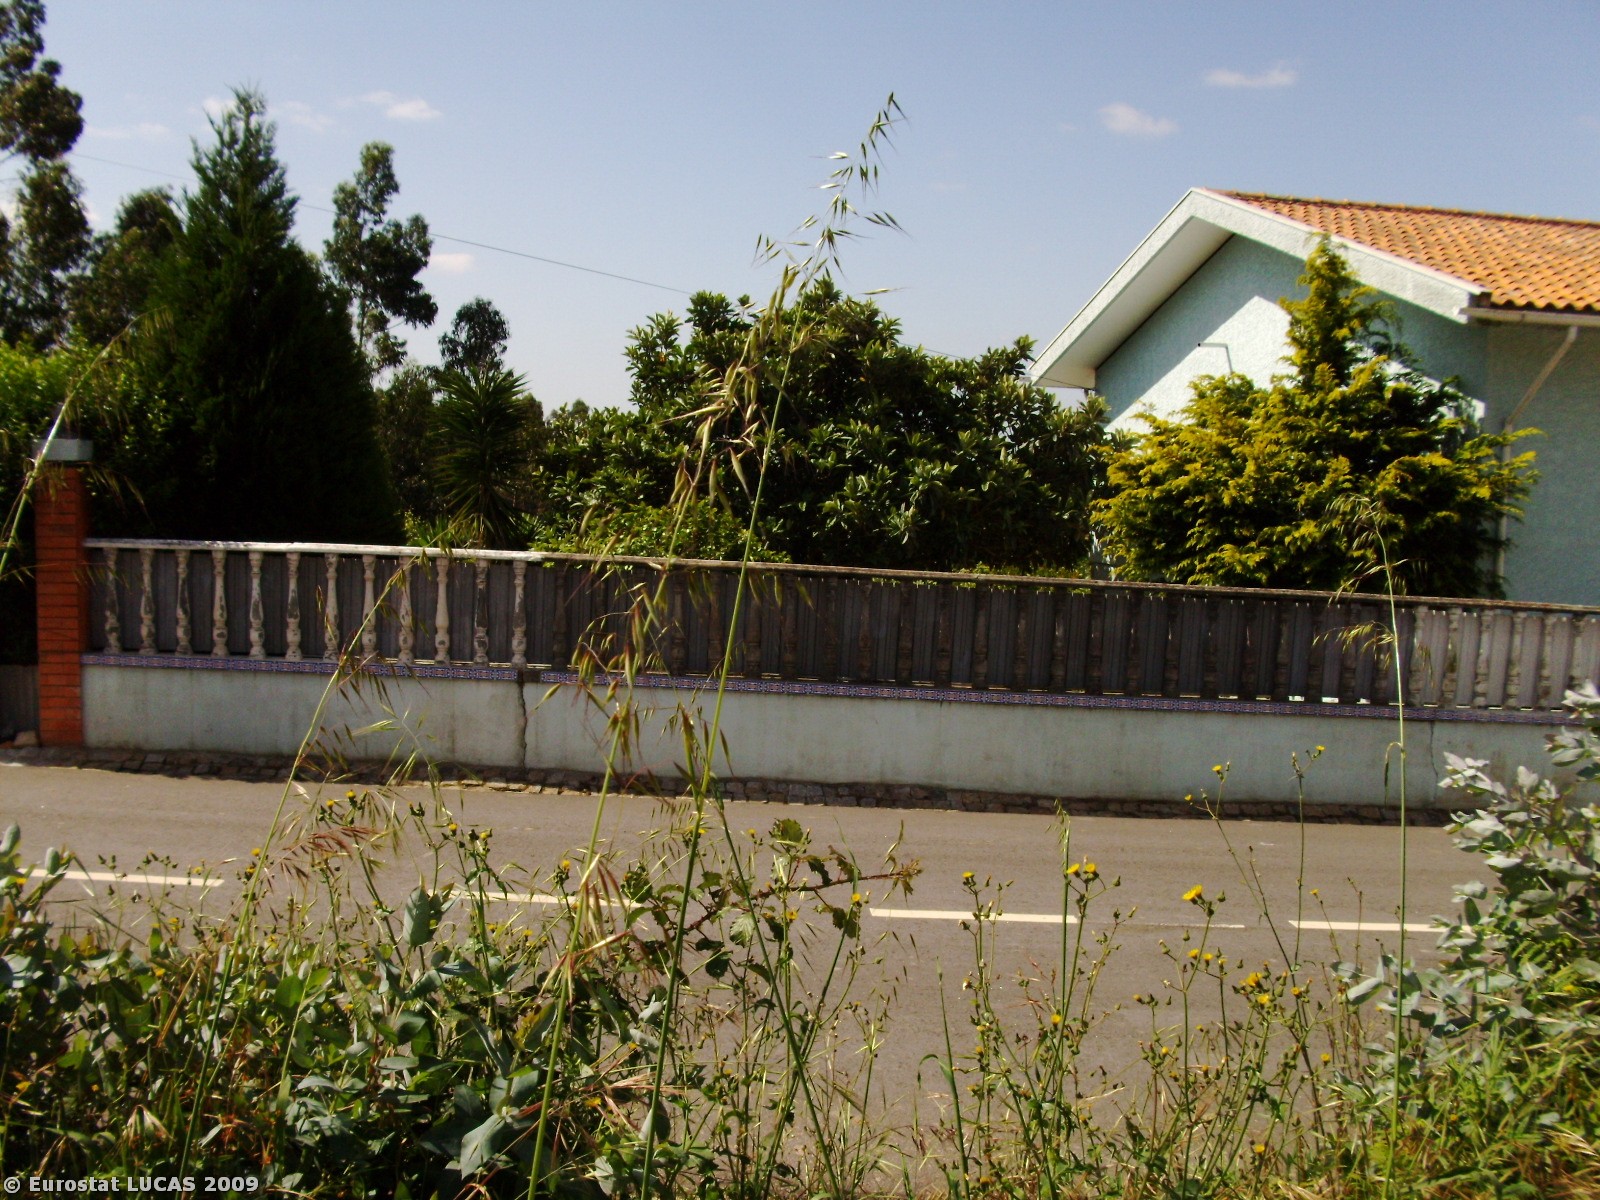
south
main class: Woodland
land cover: Broadleaved woodland
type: plantations and self-sown exotic forest
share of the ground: 25 - 50 %
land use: Forestry
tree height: > 5 m
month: May
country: PT
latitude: 40.8893
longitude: -8.5303
